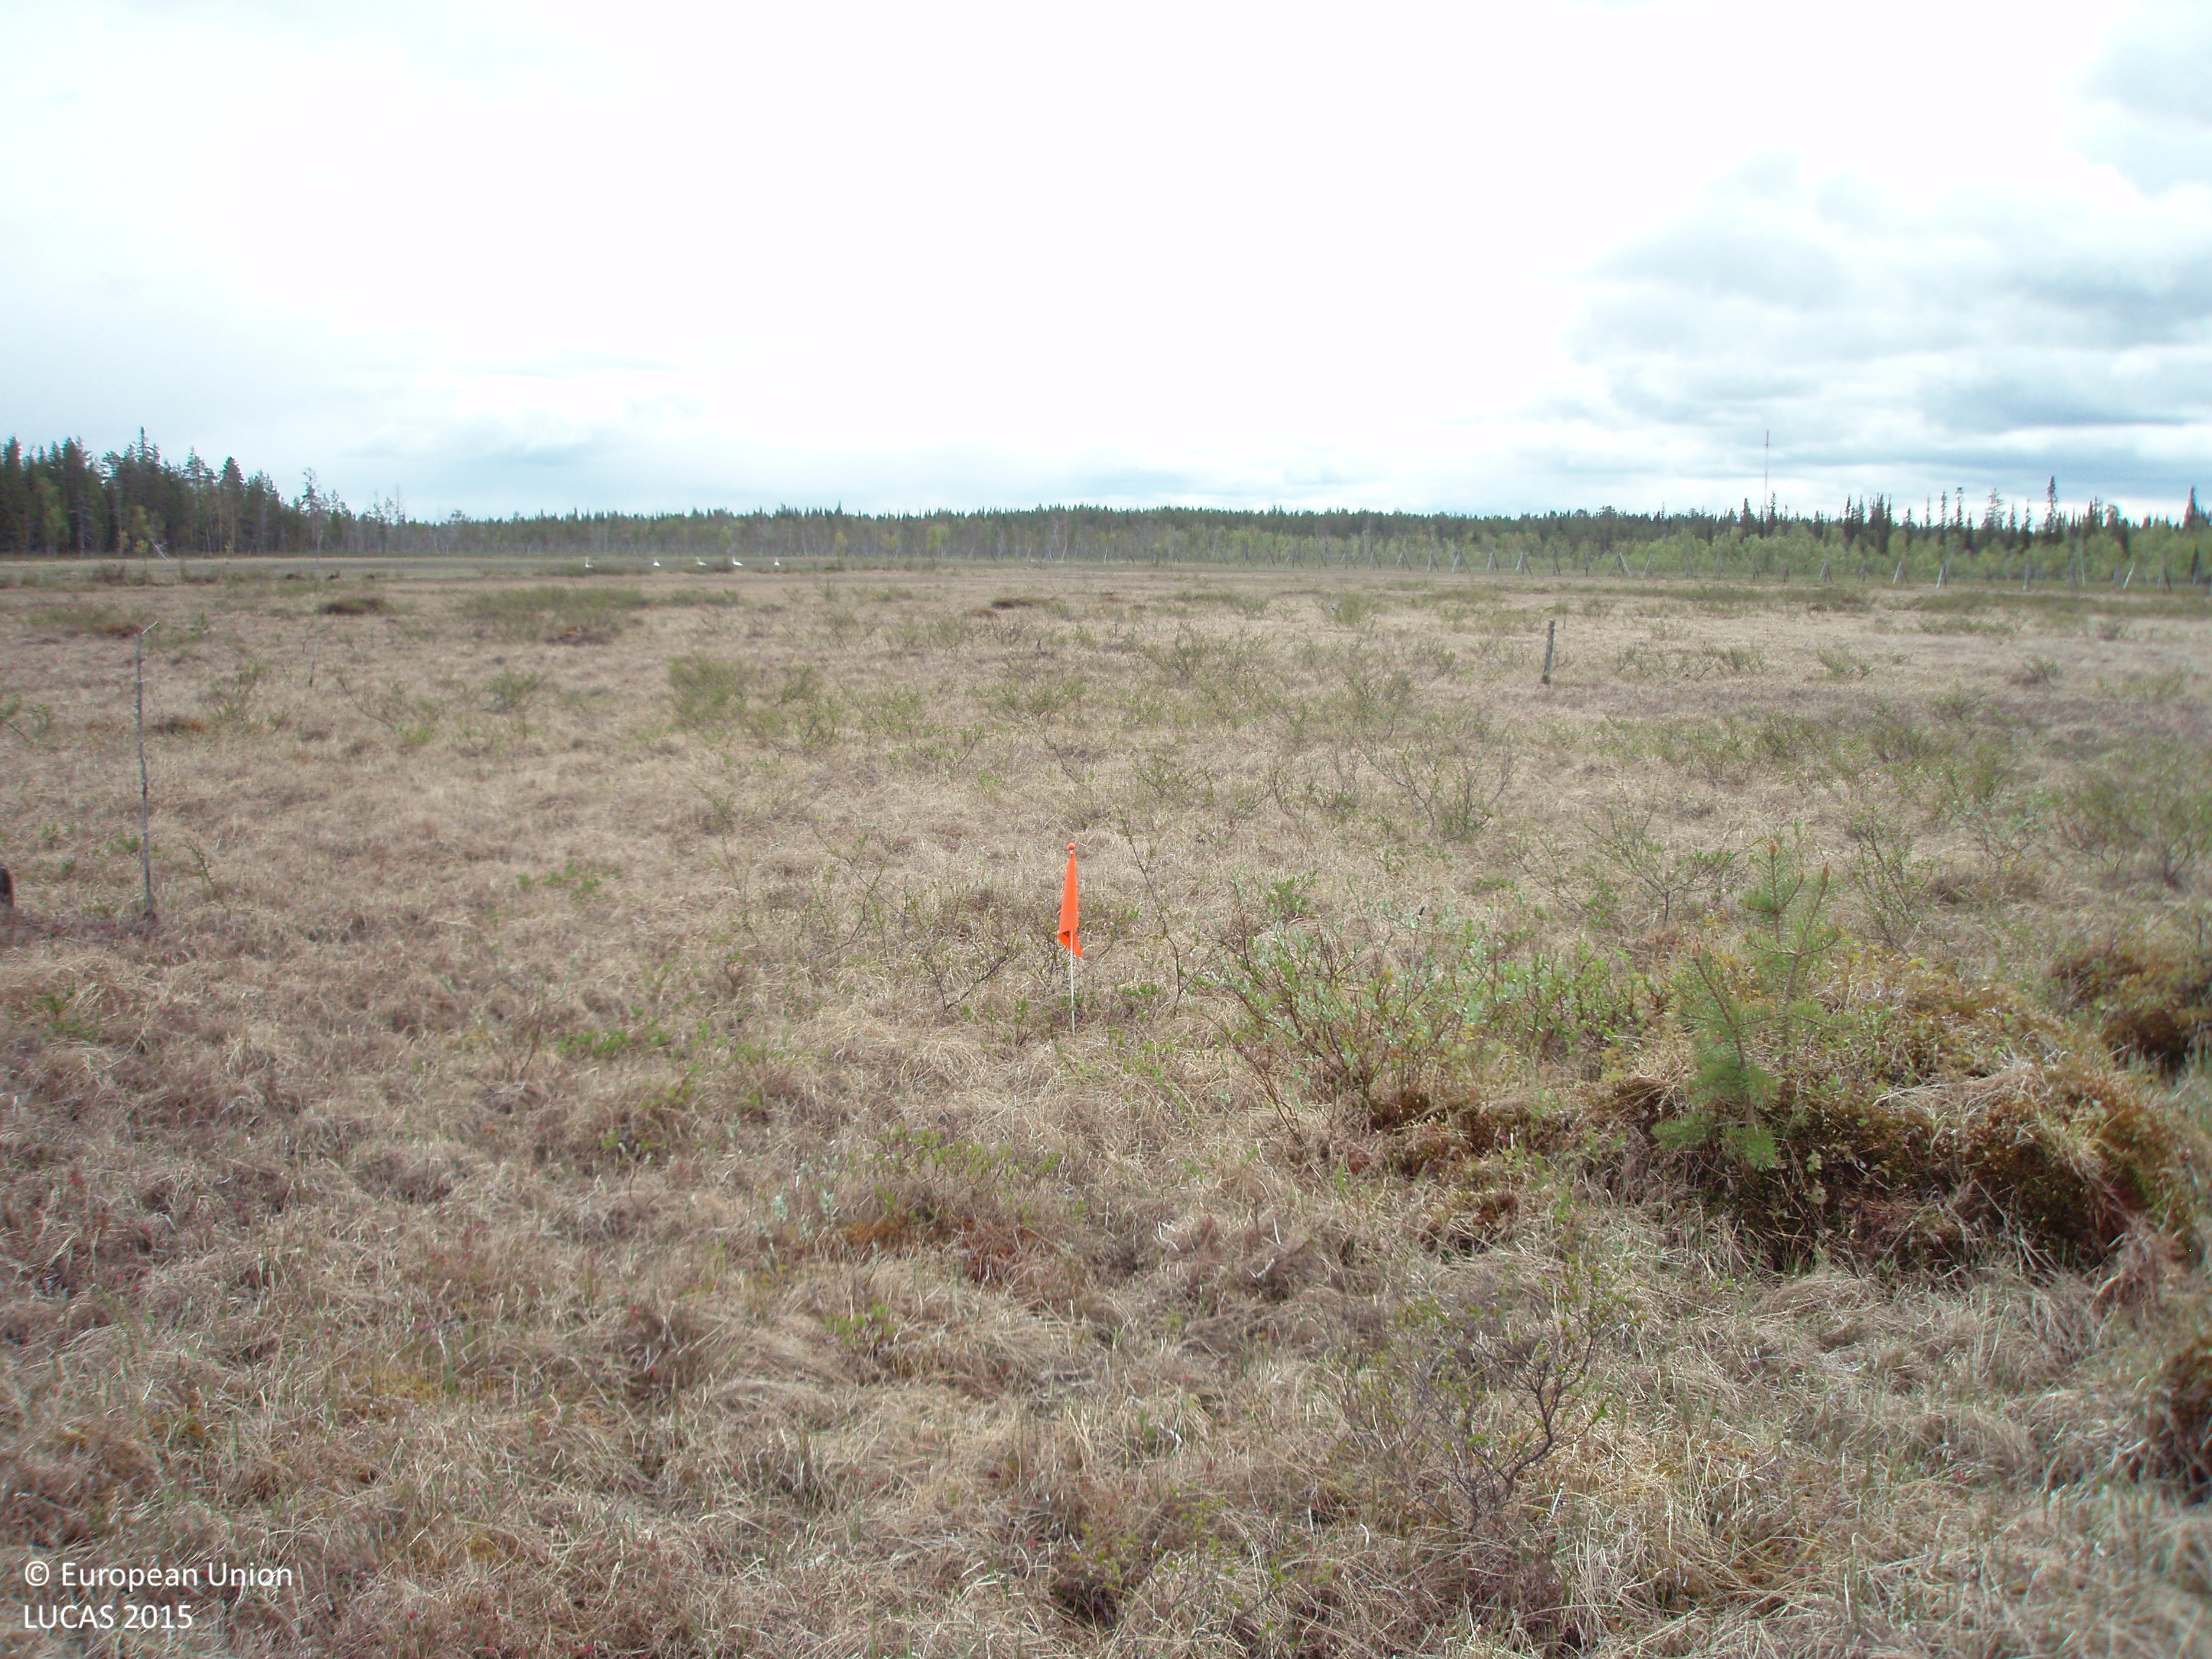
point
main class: Shrubland
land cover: Shrubland without tree cover
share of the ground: > 75 %
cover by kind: shrubs 60 %, herbaceous plants 40 %
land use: Semi-natural and natural areas not in use
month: June
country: FI
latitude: 67.9625
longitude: 26.7637
